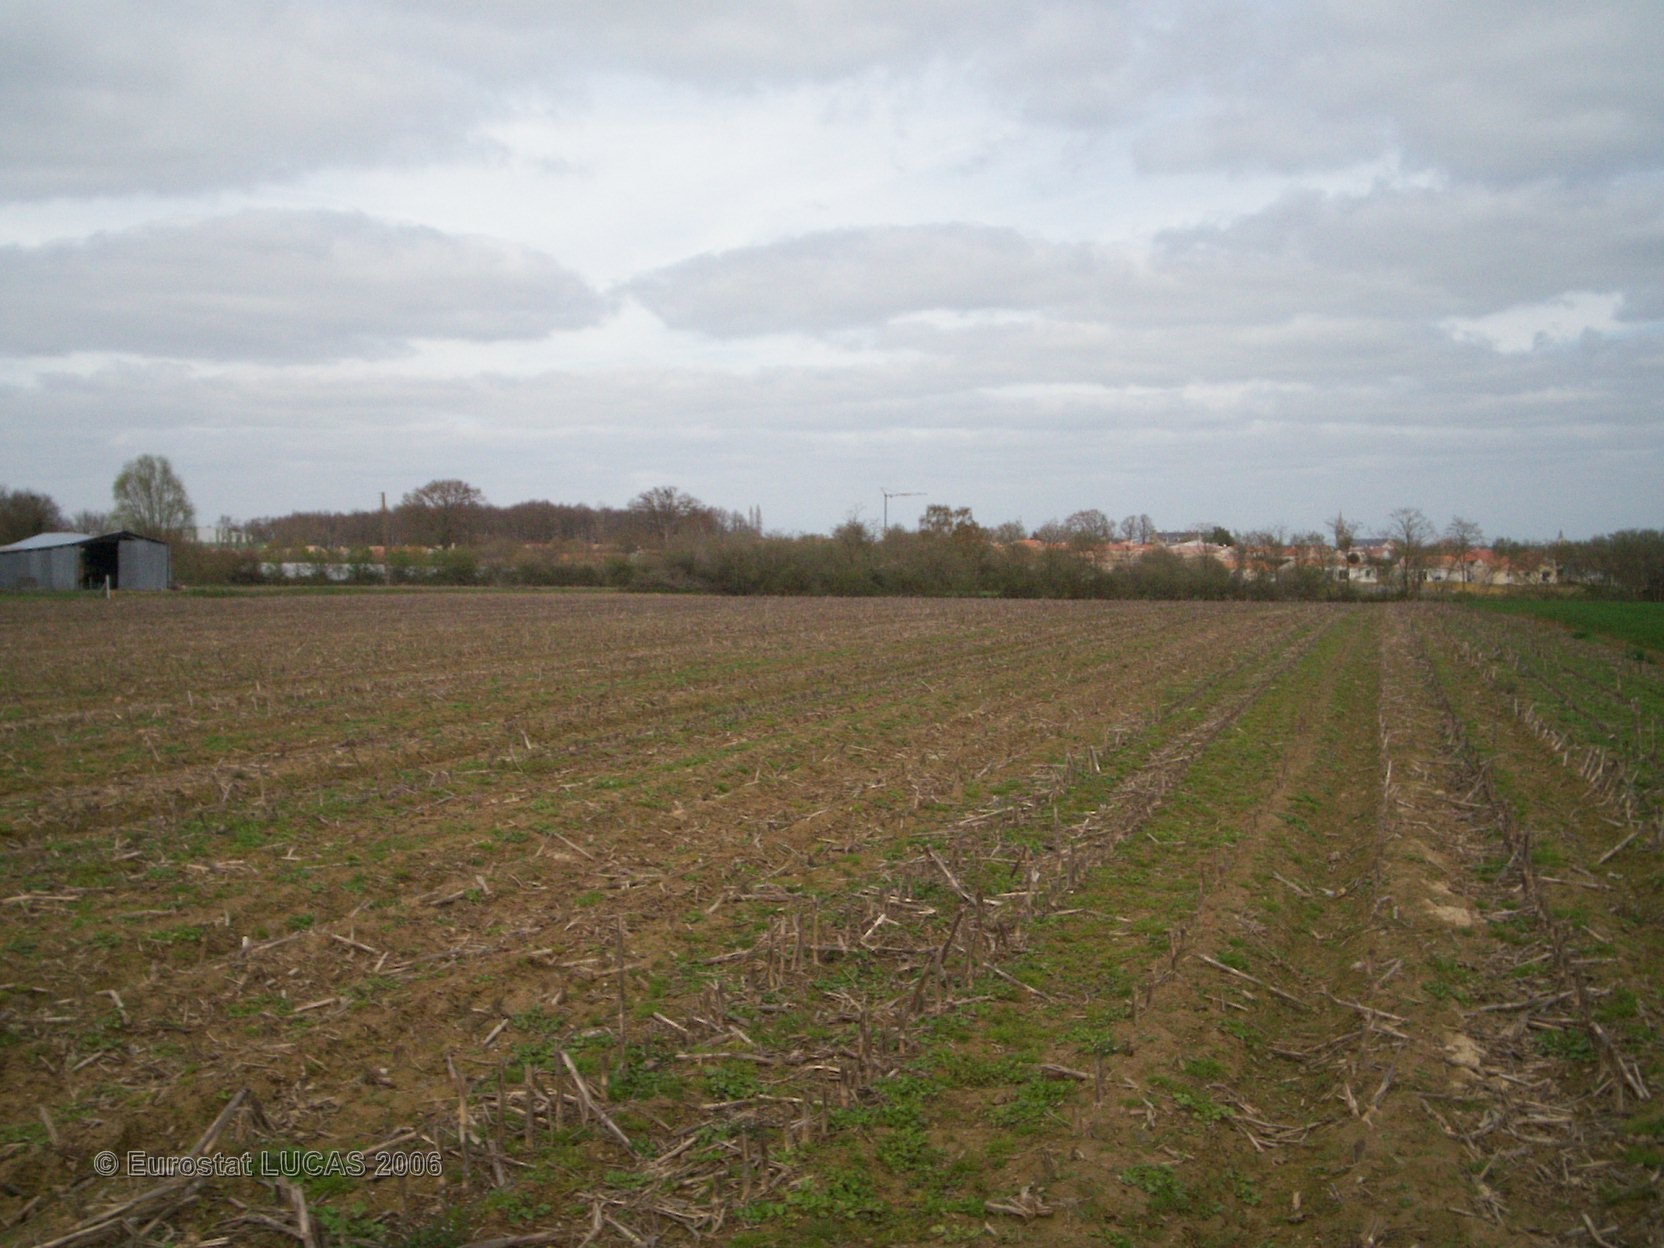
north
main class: Cropland
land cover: Maize
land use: Agriculture (excluding fallow land and kitchen gardens)
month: May
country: FR
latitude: 46.8819
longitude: -1.2563
